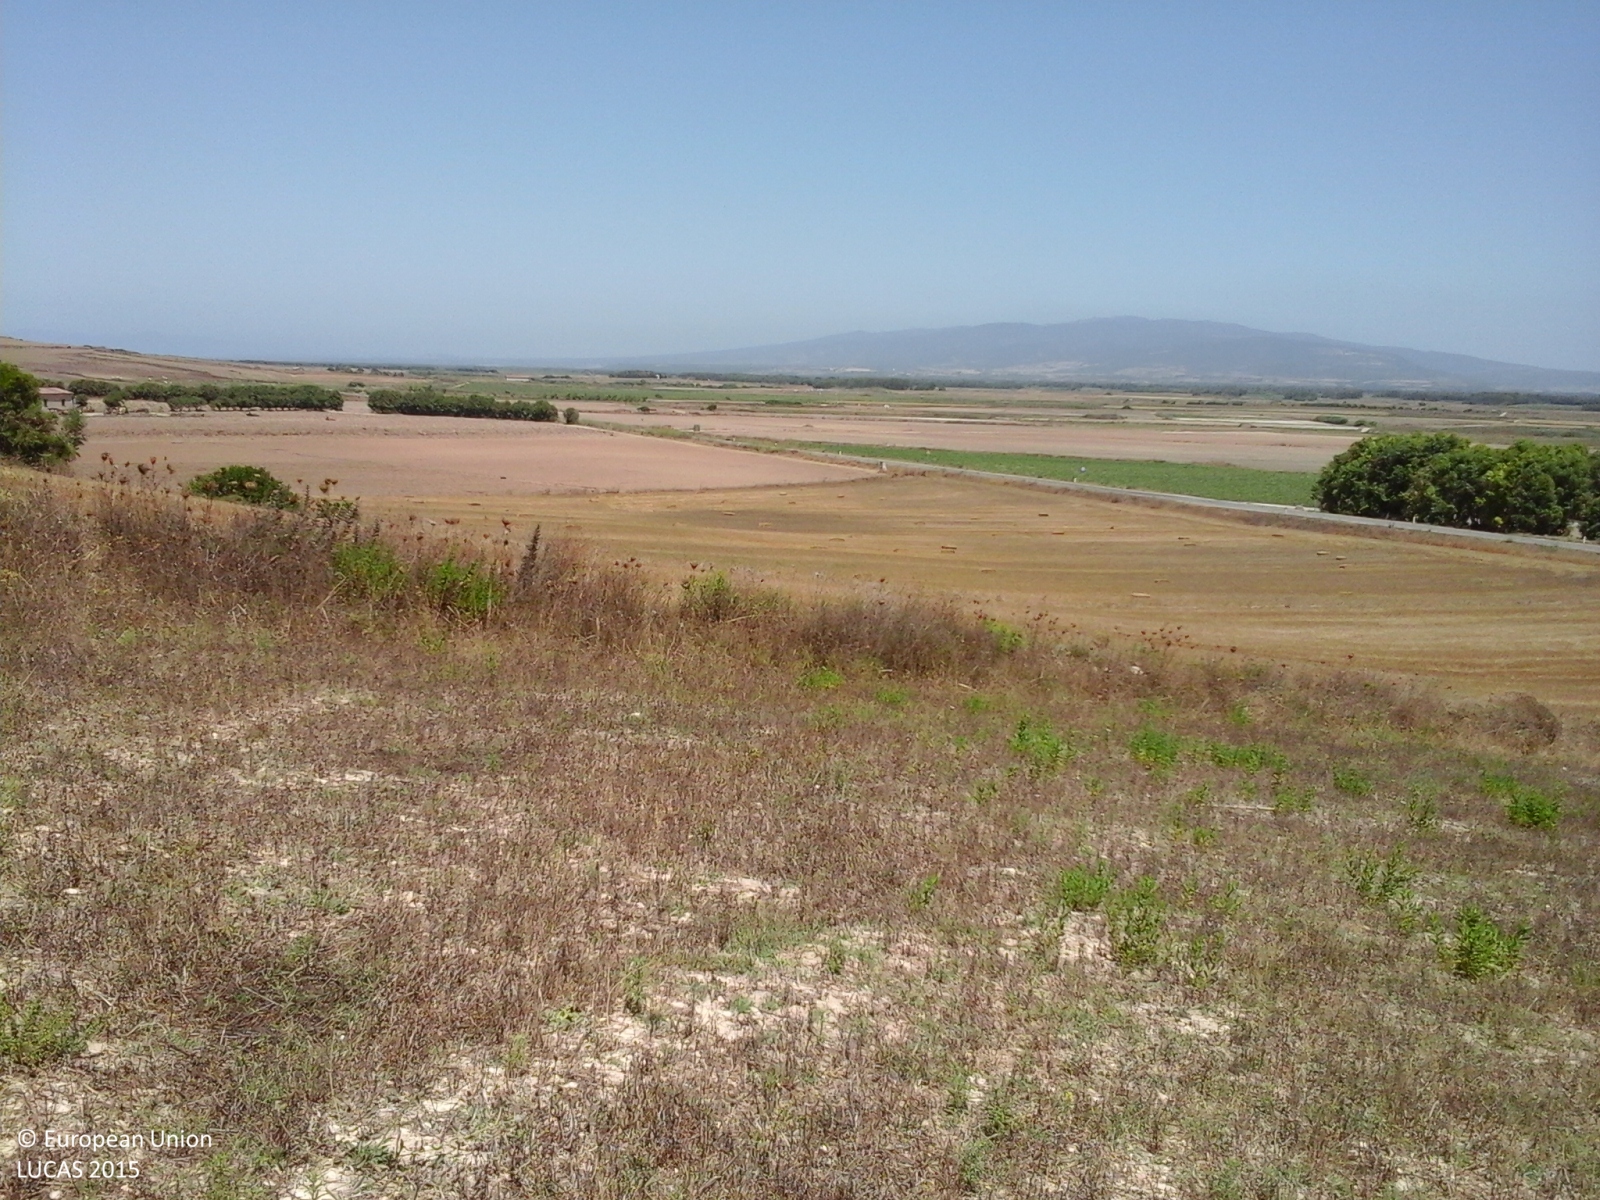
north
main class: Cropland
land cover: Mixed cereals for fodder
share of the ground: > 75 %
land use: Agriculture (excluding fallow land and kitchen gardens)
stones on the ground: < 10 %
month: July
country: IT
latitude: 39.9654
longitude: 8.4514
